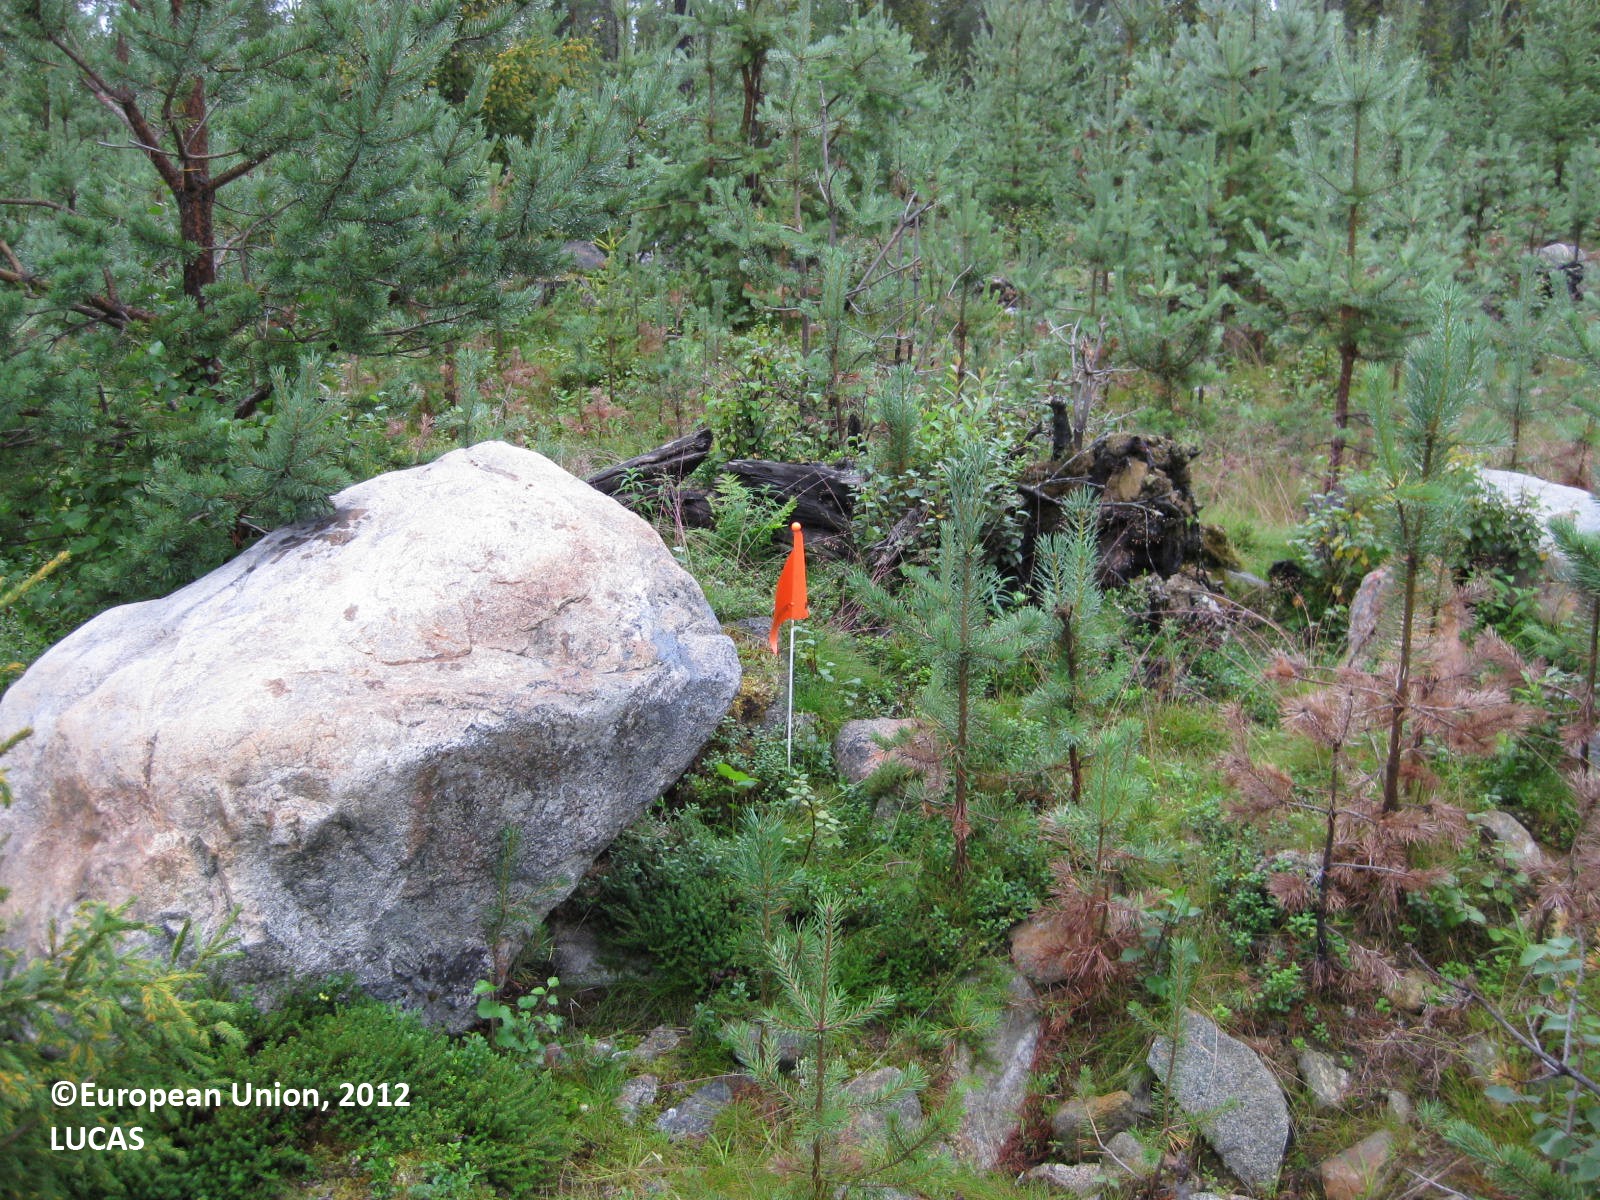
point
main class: Woodland
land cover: Pine dominated coniferous woodland
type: boreal forest
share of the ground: 50 - 75 %
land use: Forestry
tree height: < 5 m
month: August
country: FI
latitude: 65.8325
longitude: 28.2057
